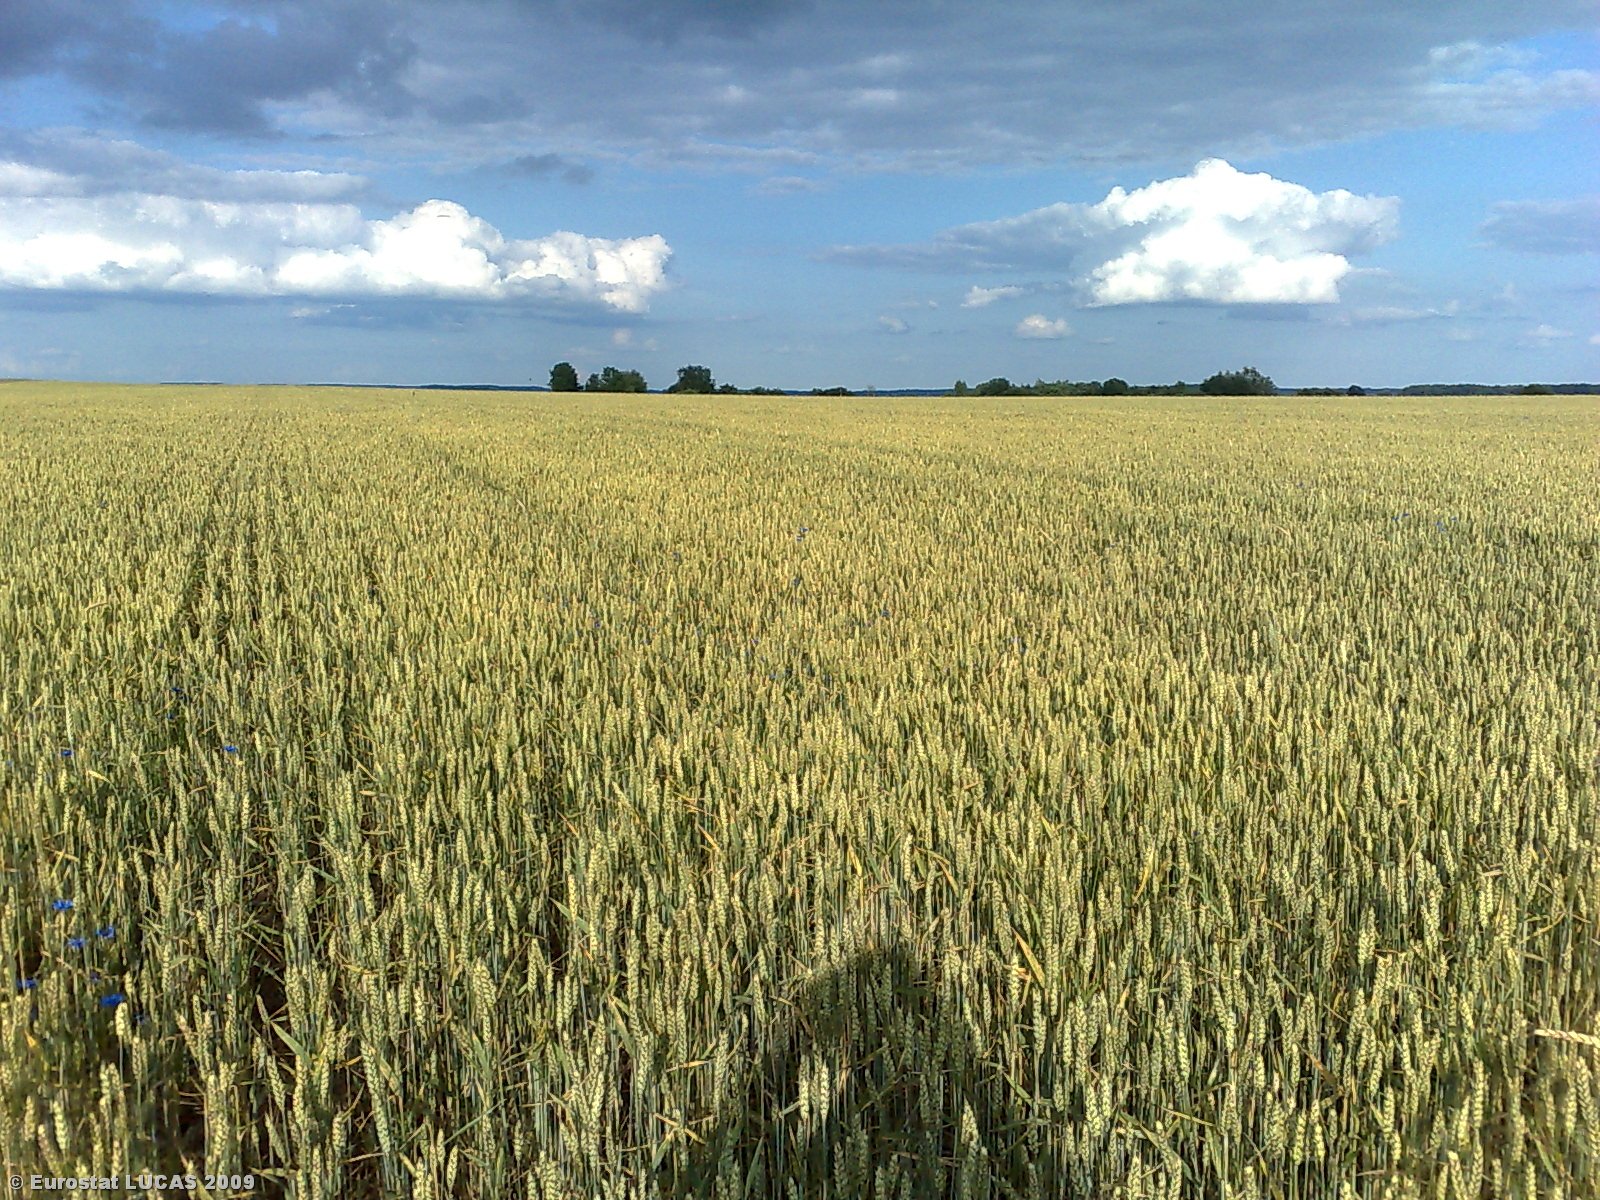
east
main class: Cropland
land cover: Common wheat
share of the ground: > 75 %
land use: Agriculture (excluding fallow land and kitchen gardens)
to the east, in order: Common wheat
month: July
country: LT
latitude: 55.7414
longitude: 22.8243
